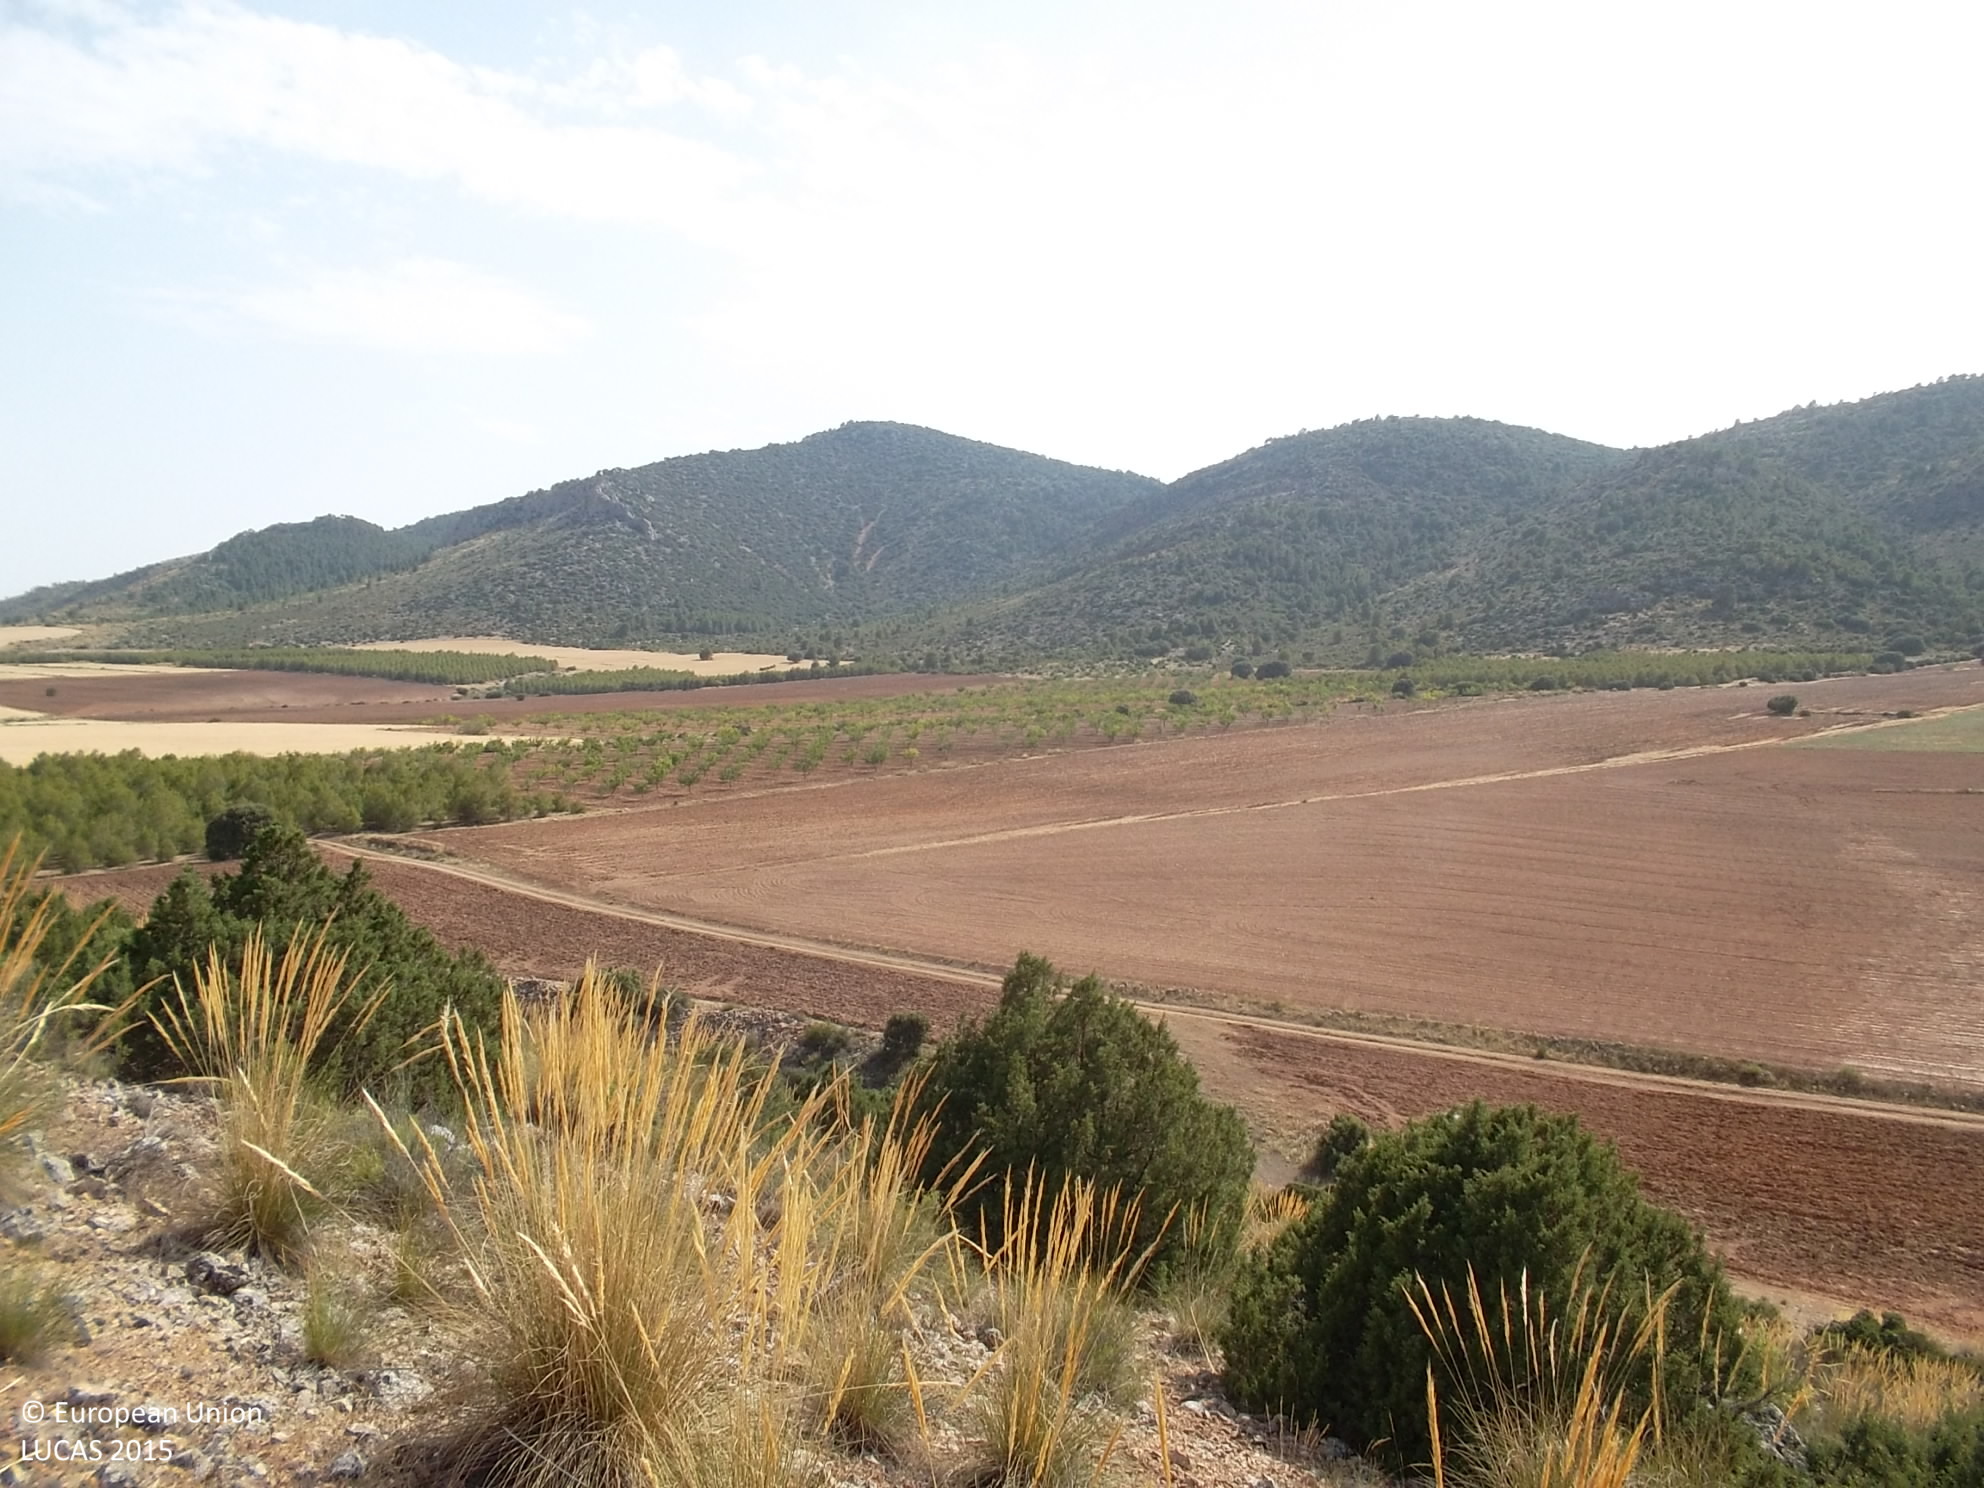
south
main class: Shrubland
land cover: Shrubland without tree cover
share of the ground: 50 - 75 %
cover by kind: shrubs 60 %, herbaceous plants 20 %, consolidated bare surface 20 %
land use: Semi-natural and natural areas not in use
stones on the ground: 25 - 50 %
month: July
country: ES
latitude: 37.8980
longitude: -2.4430
